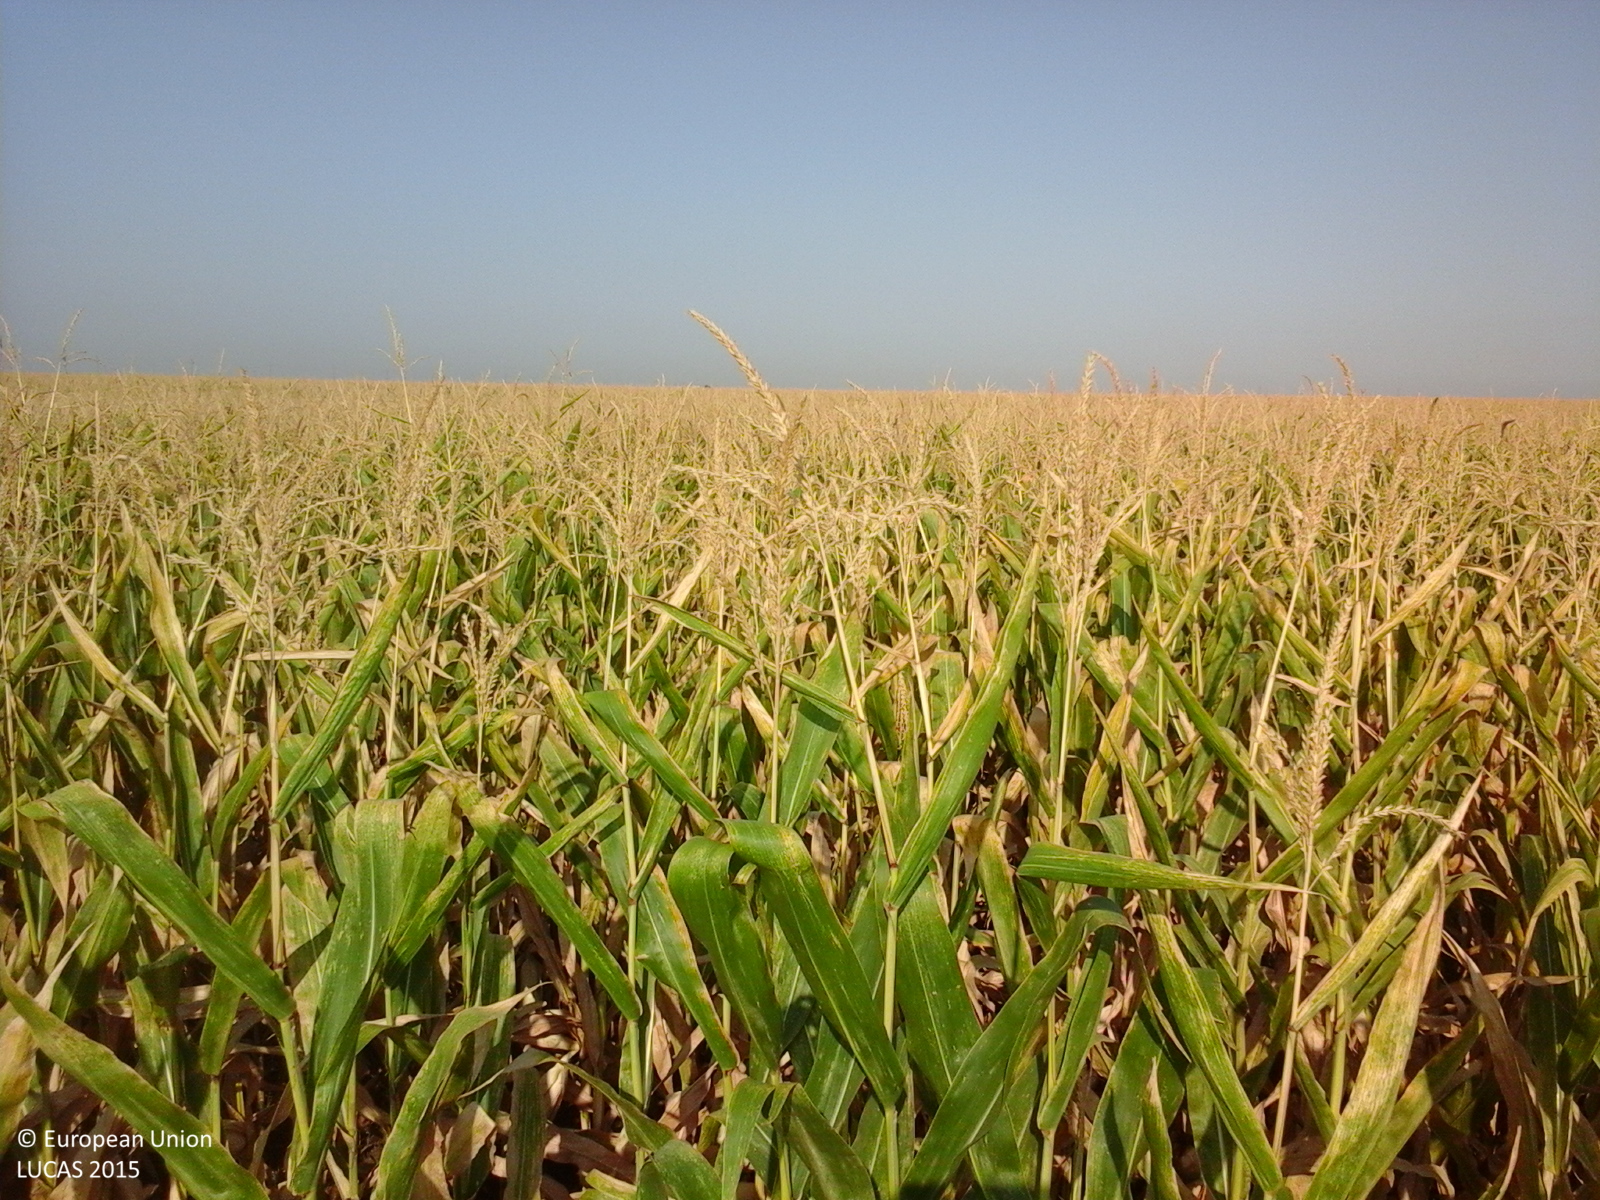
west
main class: Cropland
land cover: Maize
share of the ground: > 75 %
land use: Agriculture (excluding fallow land and kitchen gardens)
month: August
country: RO
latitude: 43.9846
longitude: 23.7044
